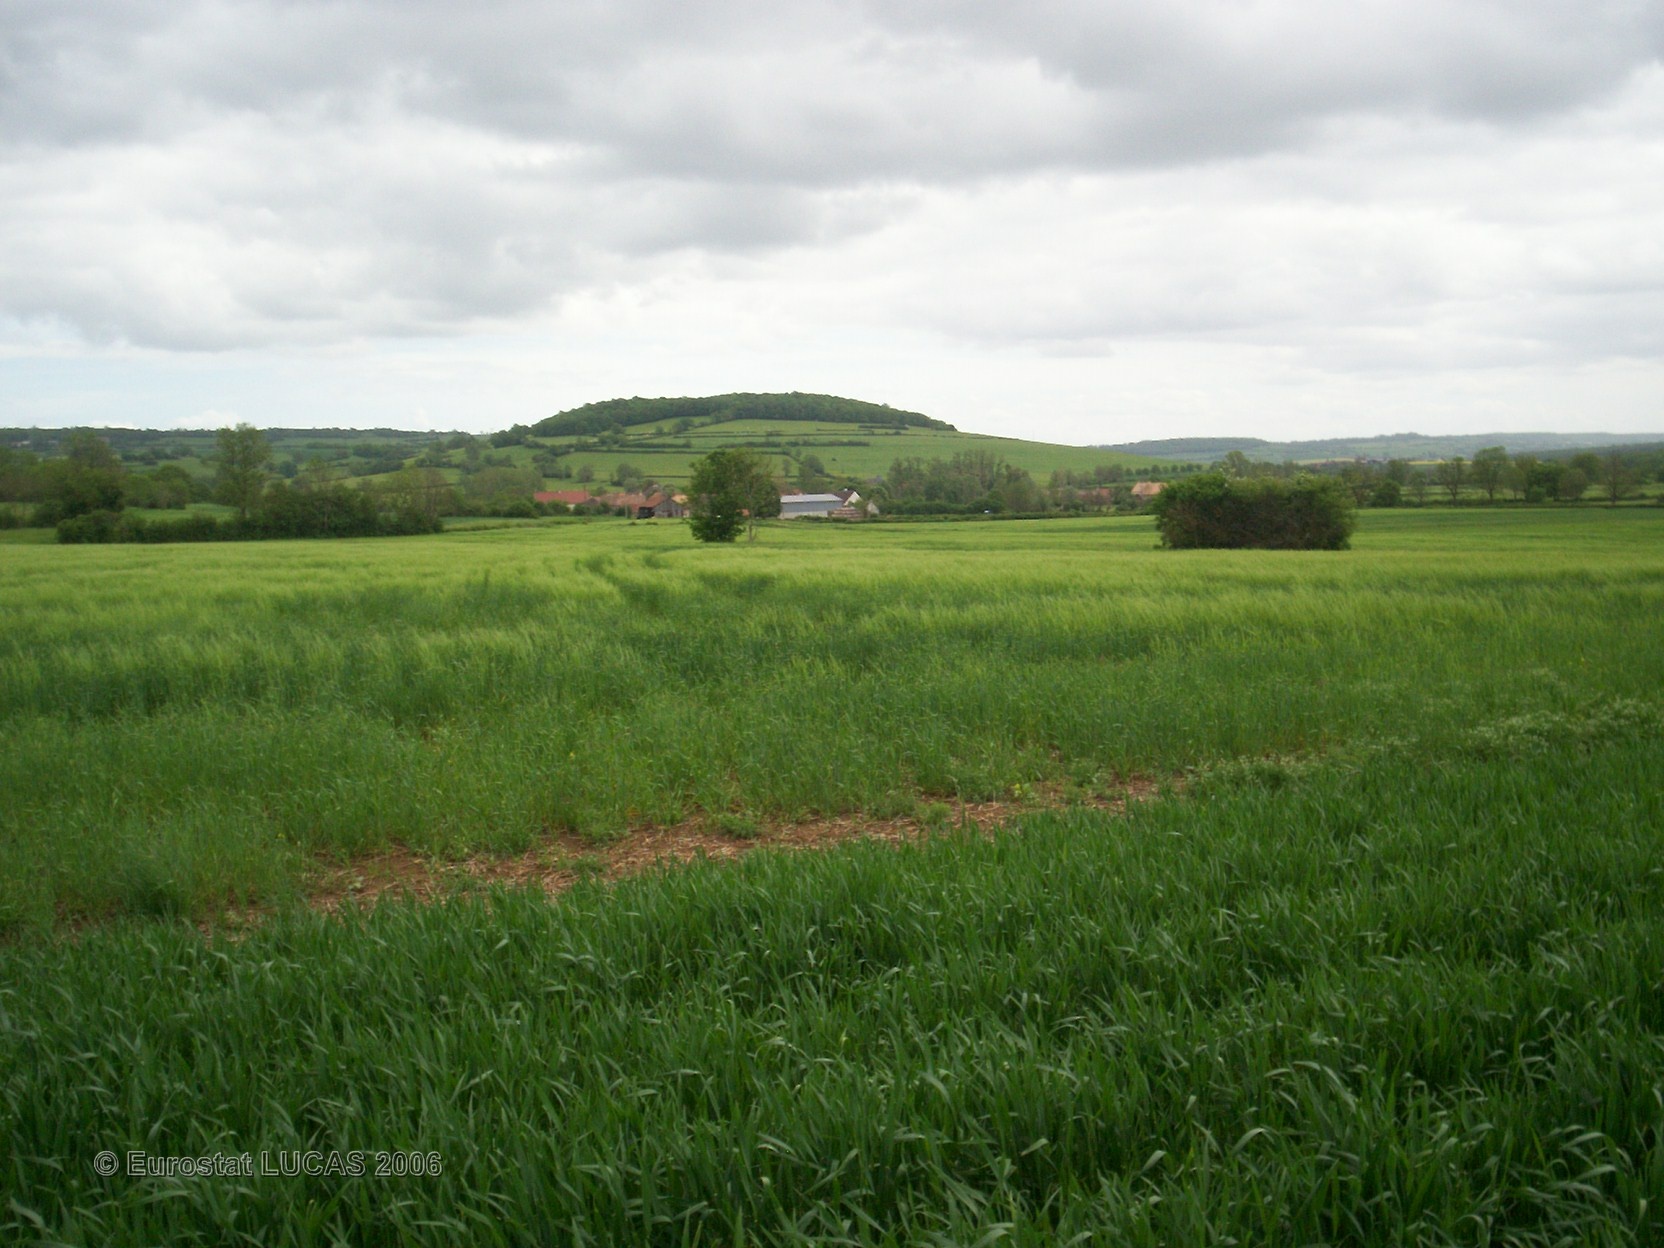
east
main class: Cropland
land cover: Common wheat
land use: Agriculture (excluding fallow land and kitchen gardens)
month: May
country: FR
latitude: 47.1535
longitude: 4.6058
